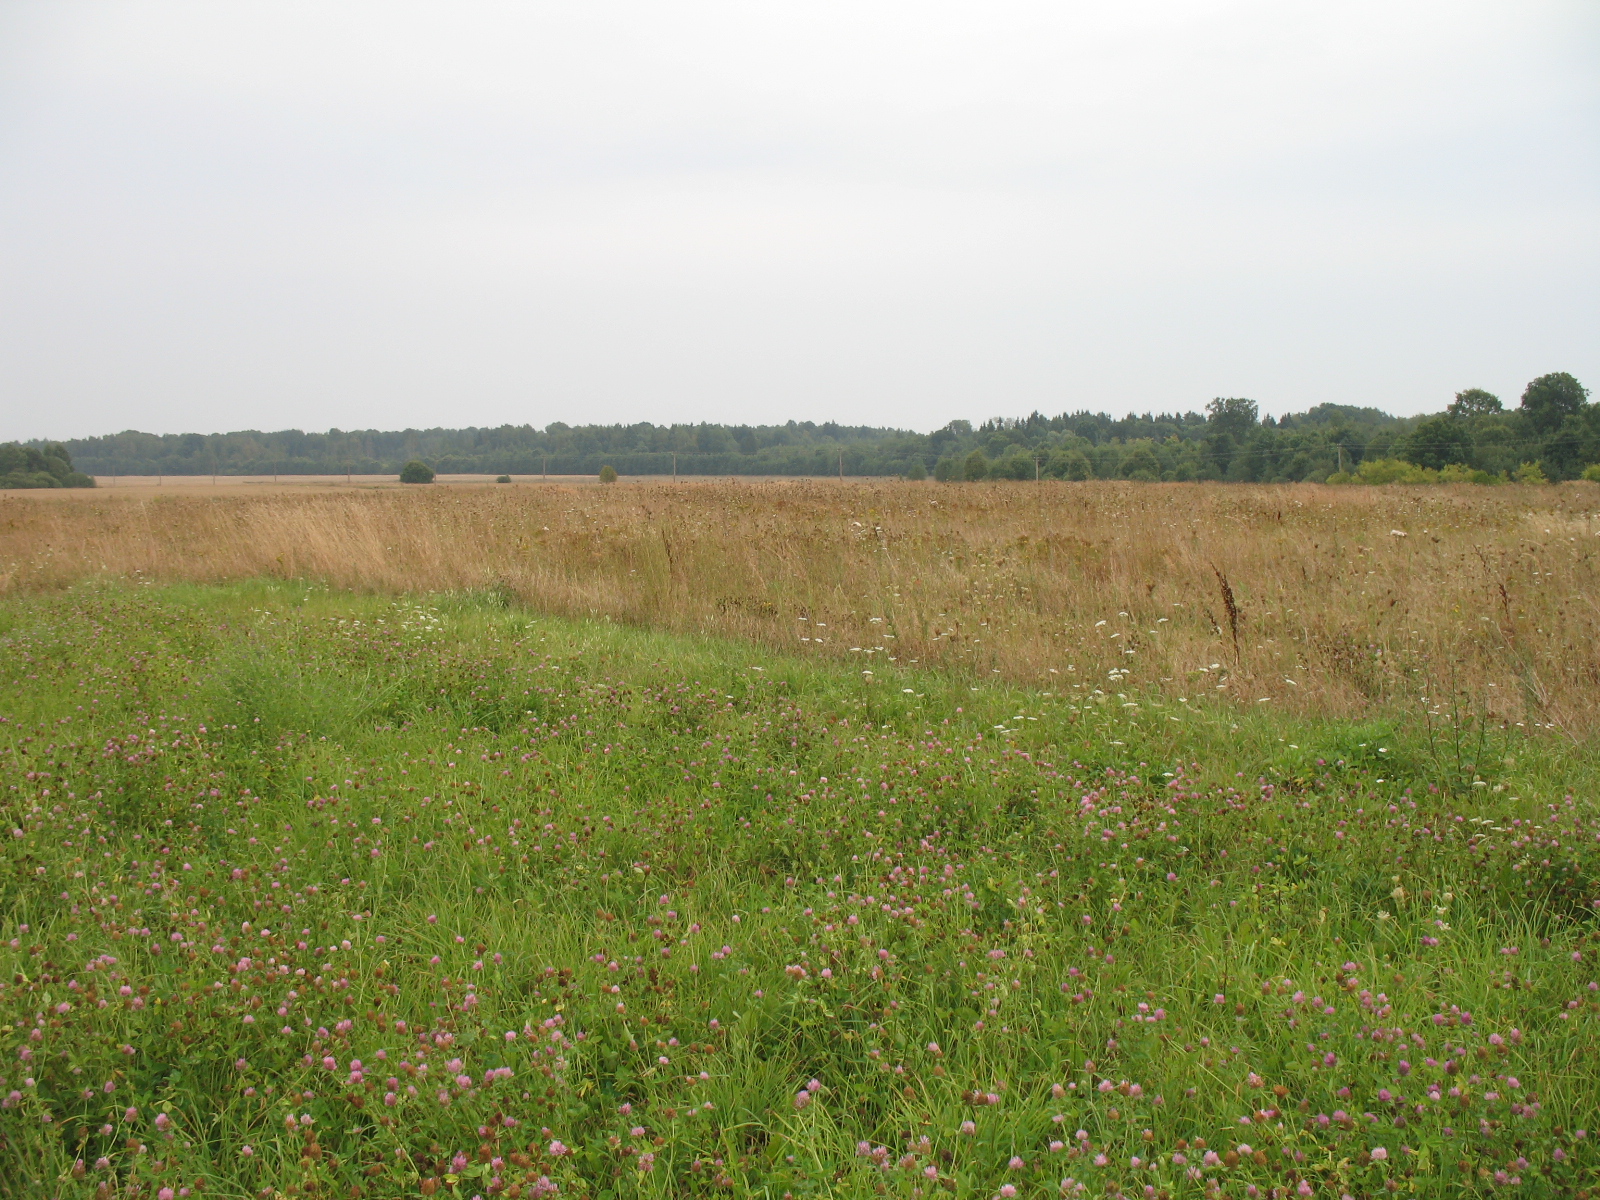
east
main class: Cropland
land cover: Clovers
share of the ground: > 75 %
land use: Agriculture (excluding fallow land and kitchen gardens)
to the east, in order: Clovers; Grassland without tree/shrub cover; Common wheat
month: August
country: LV
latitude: 56.3182
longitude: 25.9618
